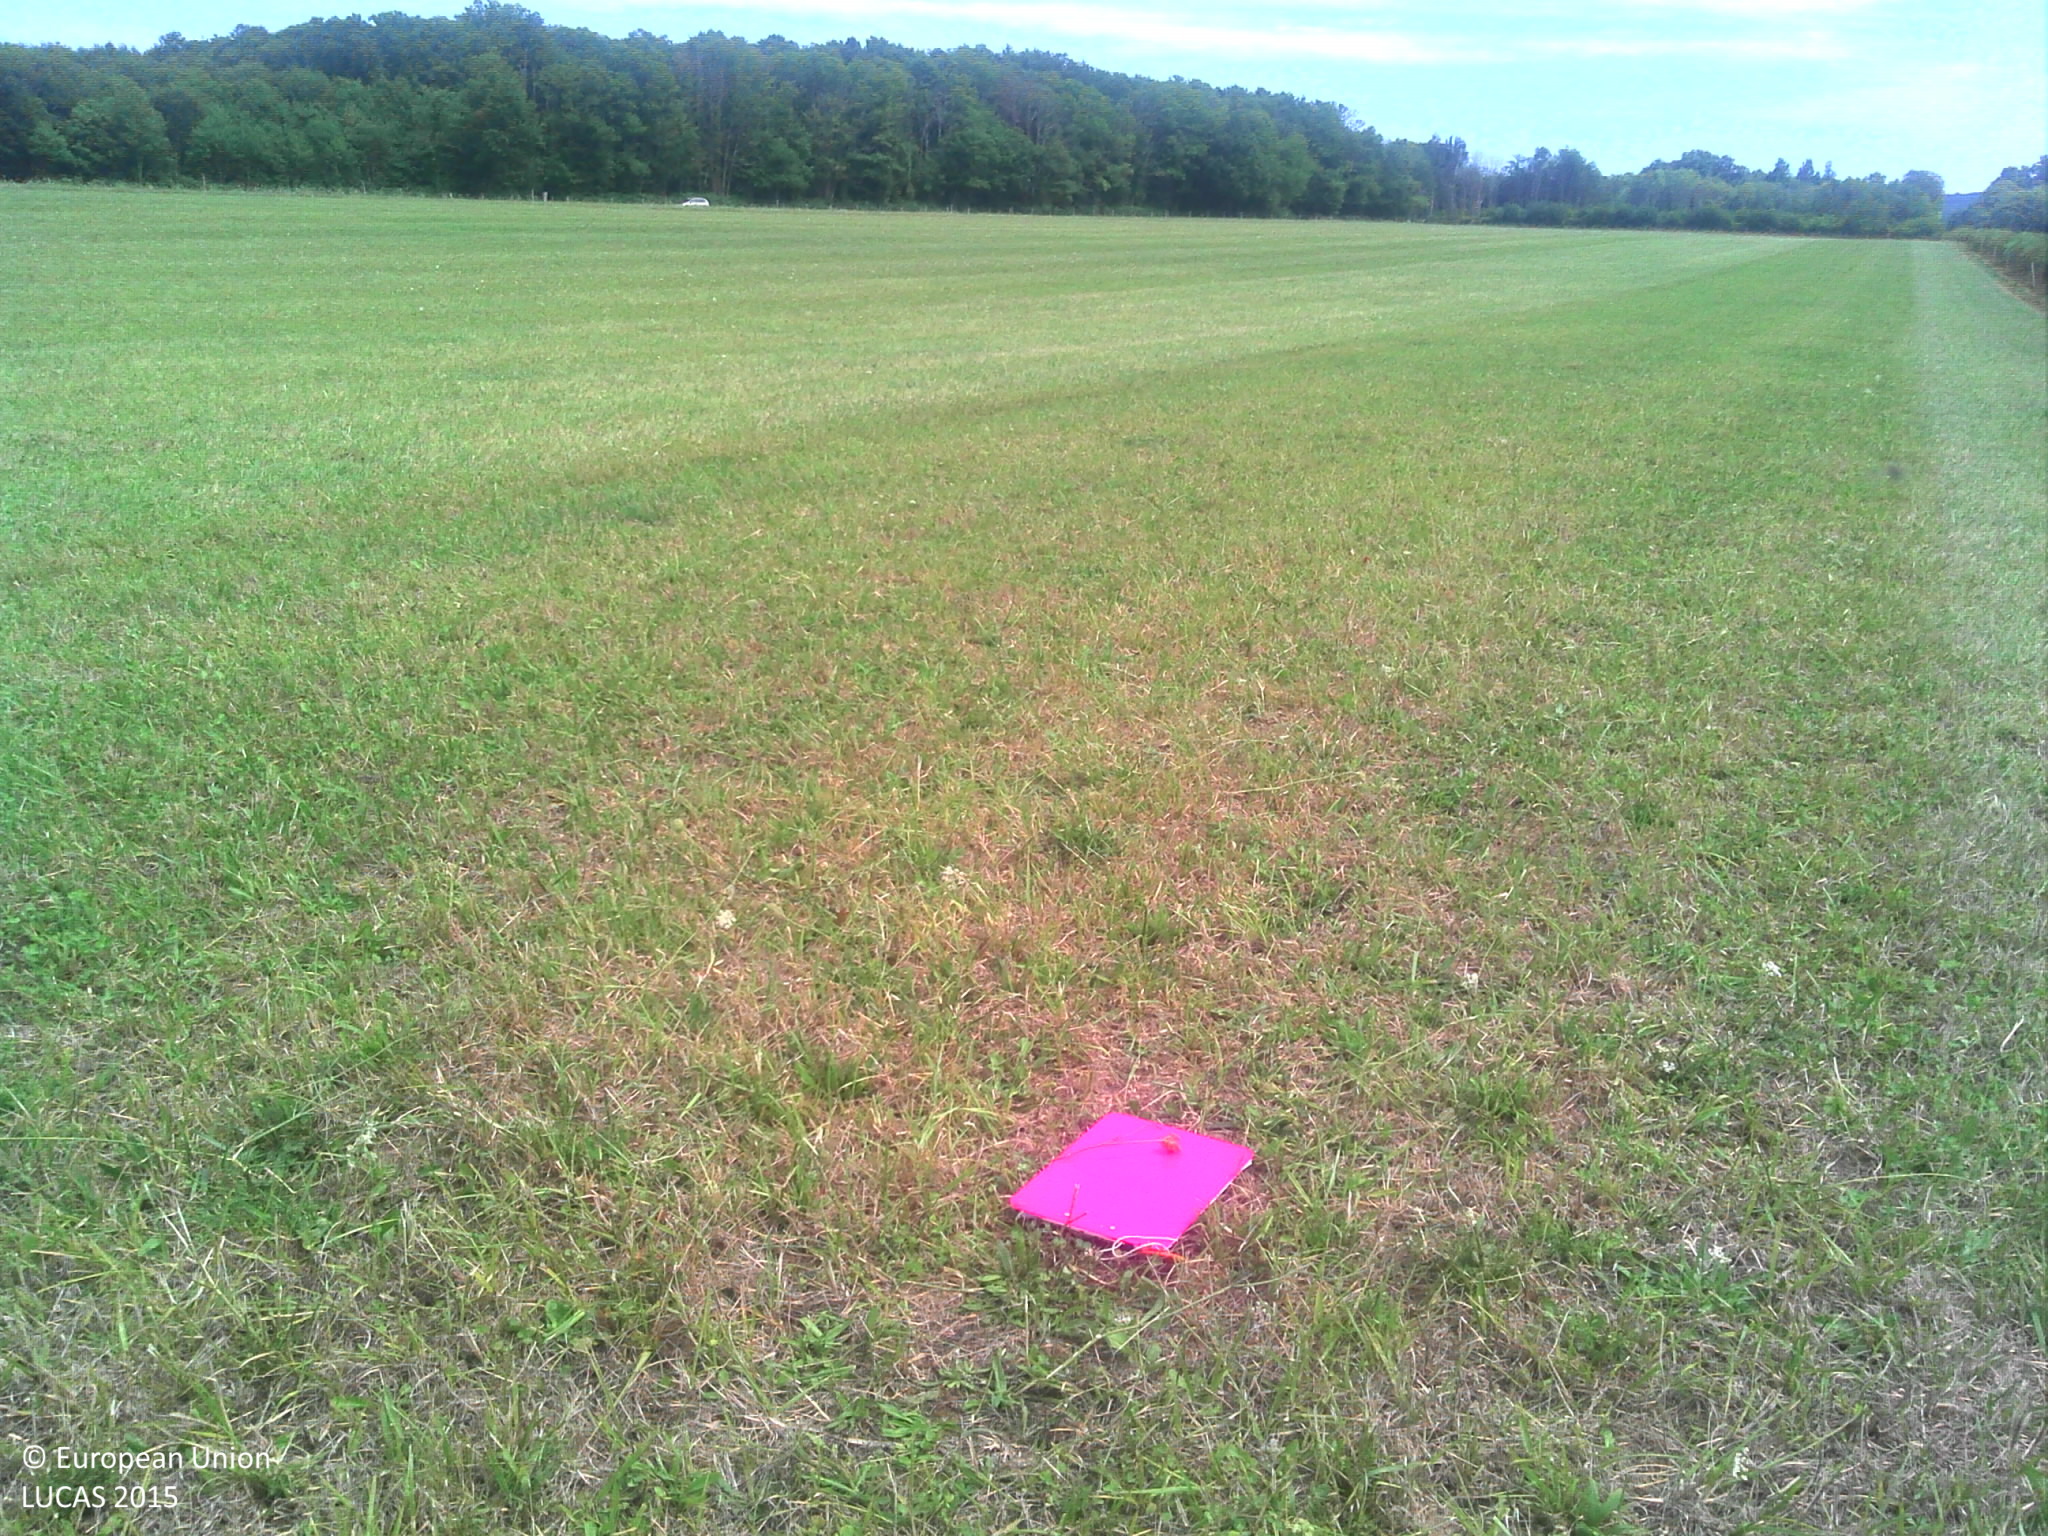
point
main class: Grassland
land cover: Grassland without tree/shrub cover
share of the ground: > 75 %
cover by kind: herbaceous plants 100 %
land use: Agriculture (excluding fallow land and kitchen gardens)
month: August
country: FR
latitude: 46.0555
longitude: 0.9270
